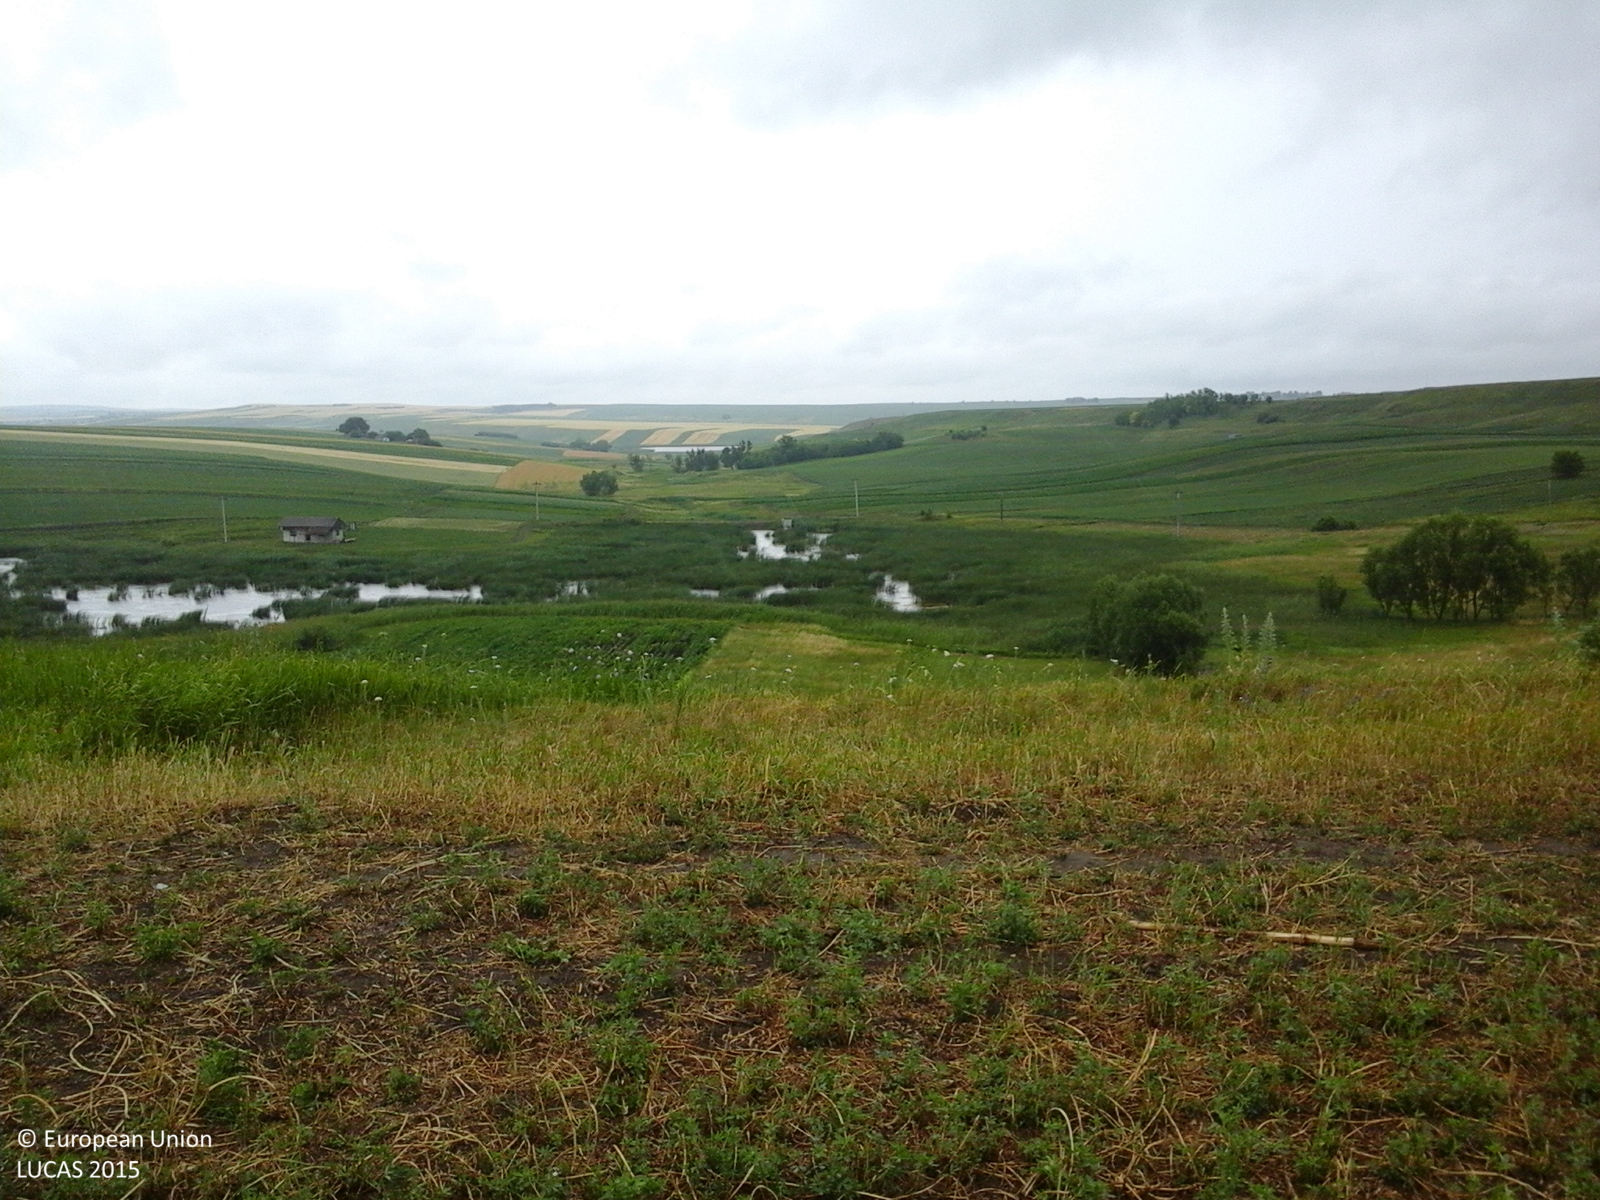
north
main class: Cropland
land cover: Lucerne
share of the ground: > 75 %
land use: Agriculture (excluding fallow land and kitchen gardens)
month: June
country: RO
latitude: 48.0252
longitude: 26.4361
